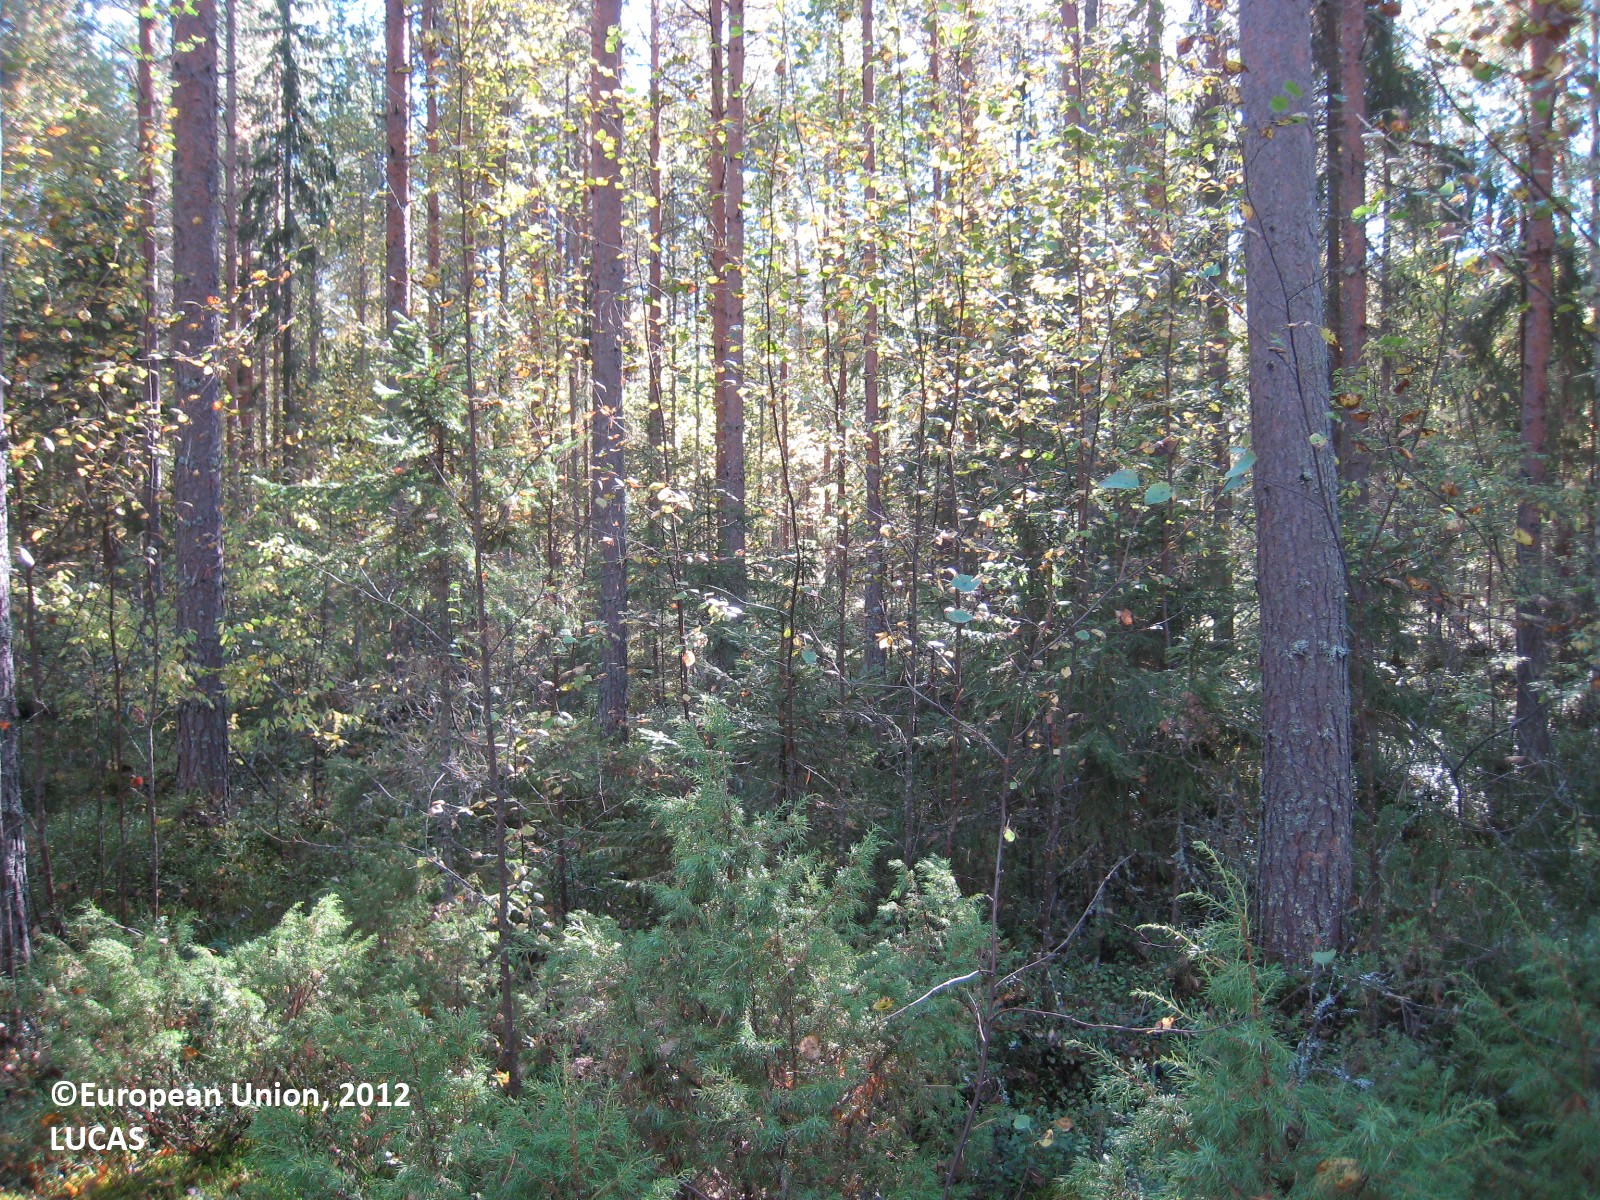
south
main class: Woodland
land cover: Pine dominated mixed woodland
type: boreal forest
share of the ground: > 75 %
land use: Forestry
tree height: > 5 m
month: September
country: FI
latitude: 62.8453
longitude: 26.6149
